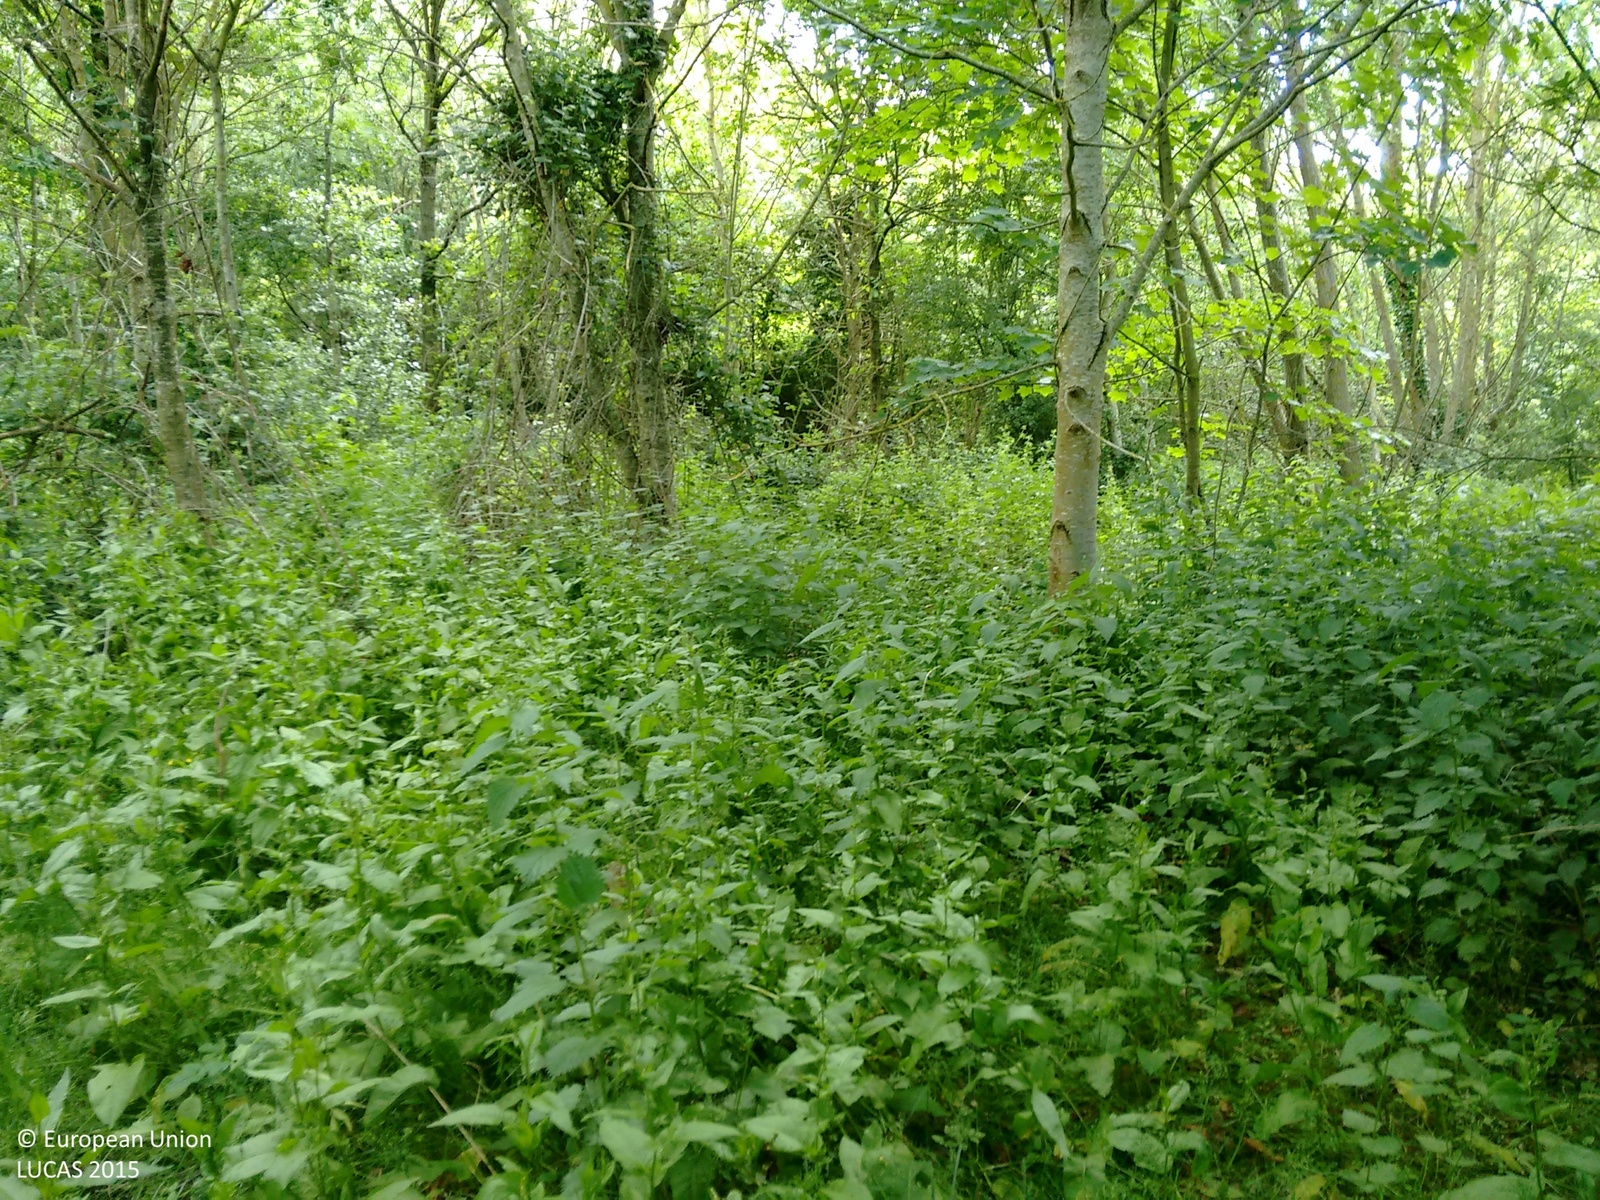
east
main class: Woodland
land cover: Broadleaved woodland
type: mesophytic deciduous forest
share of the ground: > 75 %
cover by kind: broadleaved forest trees 95 %, shrubs 5 %
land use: Forestry
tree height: > 5 m
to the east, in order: Broadleaved woodland; Fences; Grassland without tree/shrub cover; Fences; Managed hedges; Grassland without tree/shrub cover; Paved roads, cycling and walking lanes; Grass margins; Managed hedges; Grass margins; Common wheat
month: June
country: GB
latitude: 52.0591
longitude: -1.6187
